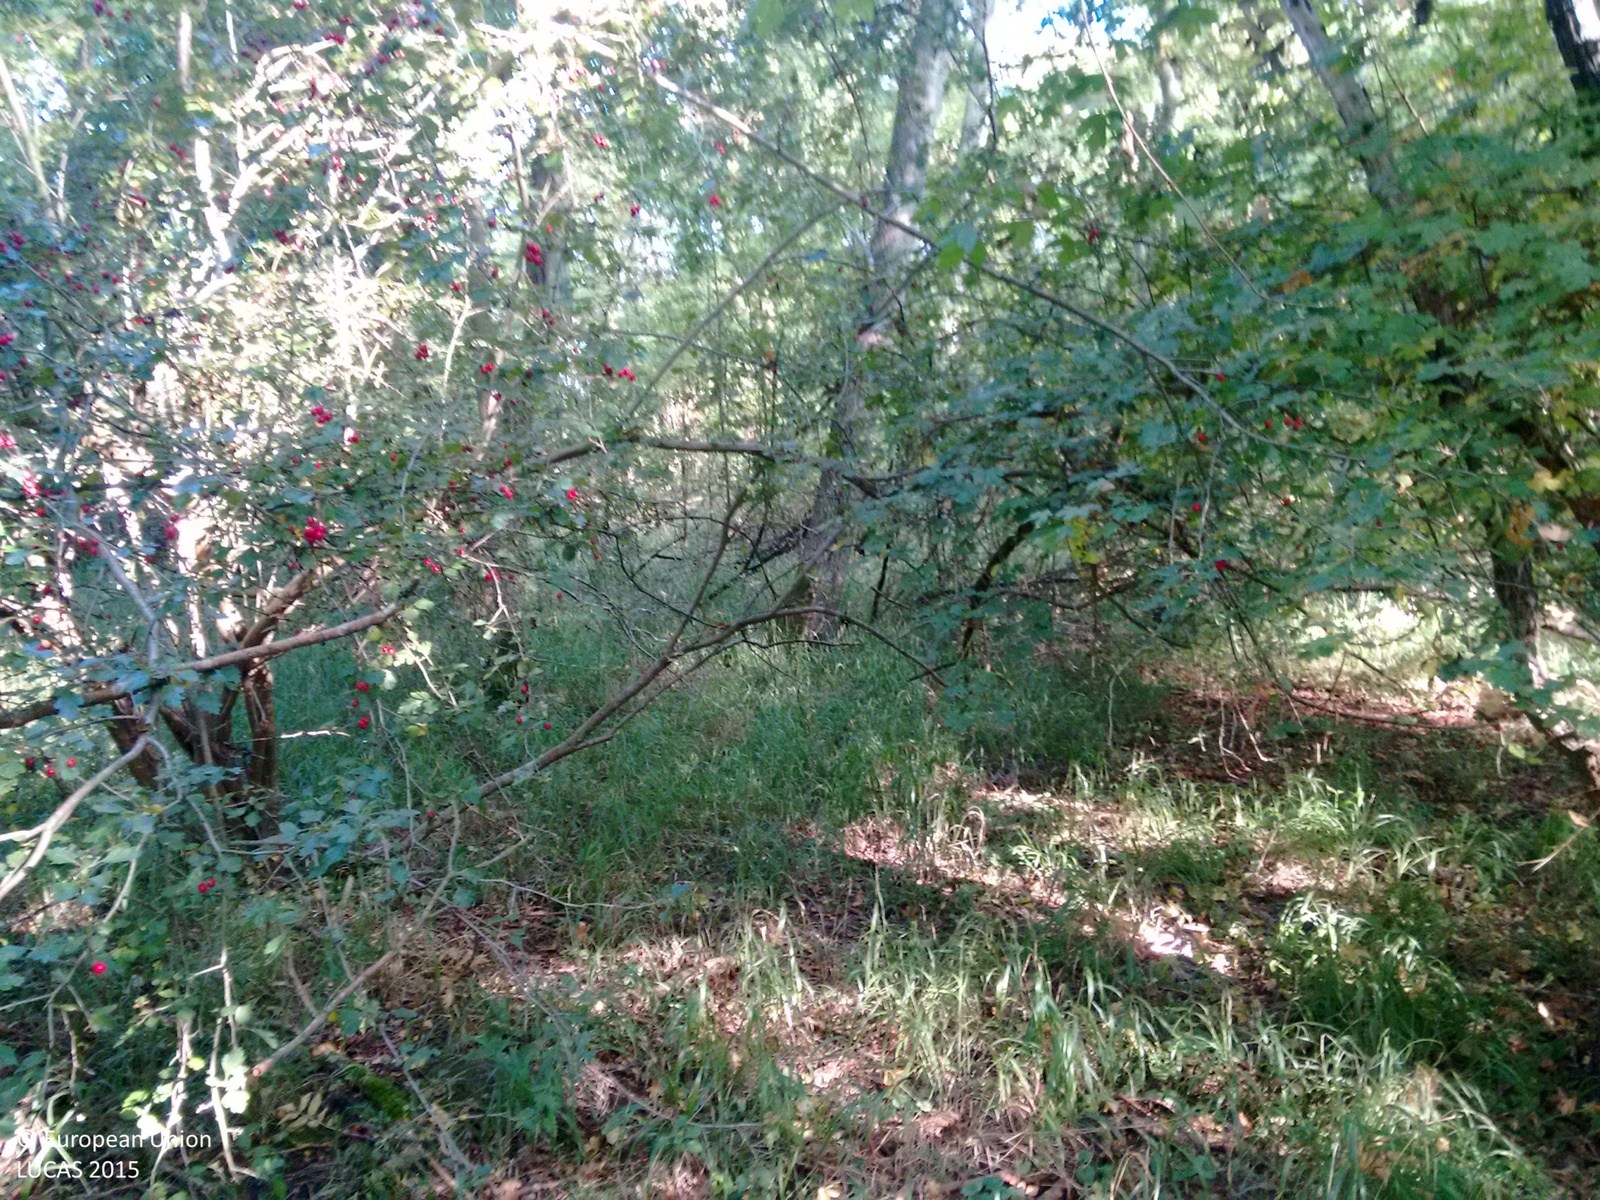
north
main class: Woodland
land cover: Broadleaved woodland
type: mesophytic deciduous forest
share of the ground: > 75 %
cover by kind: broadleaved forest trees 75 %, shrubs 25 %
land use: Amenities, museums, leisure
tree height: > 5 m
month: October
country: GB
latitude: 52.4038
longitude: -0.2509
